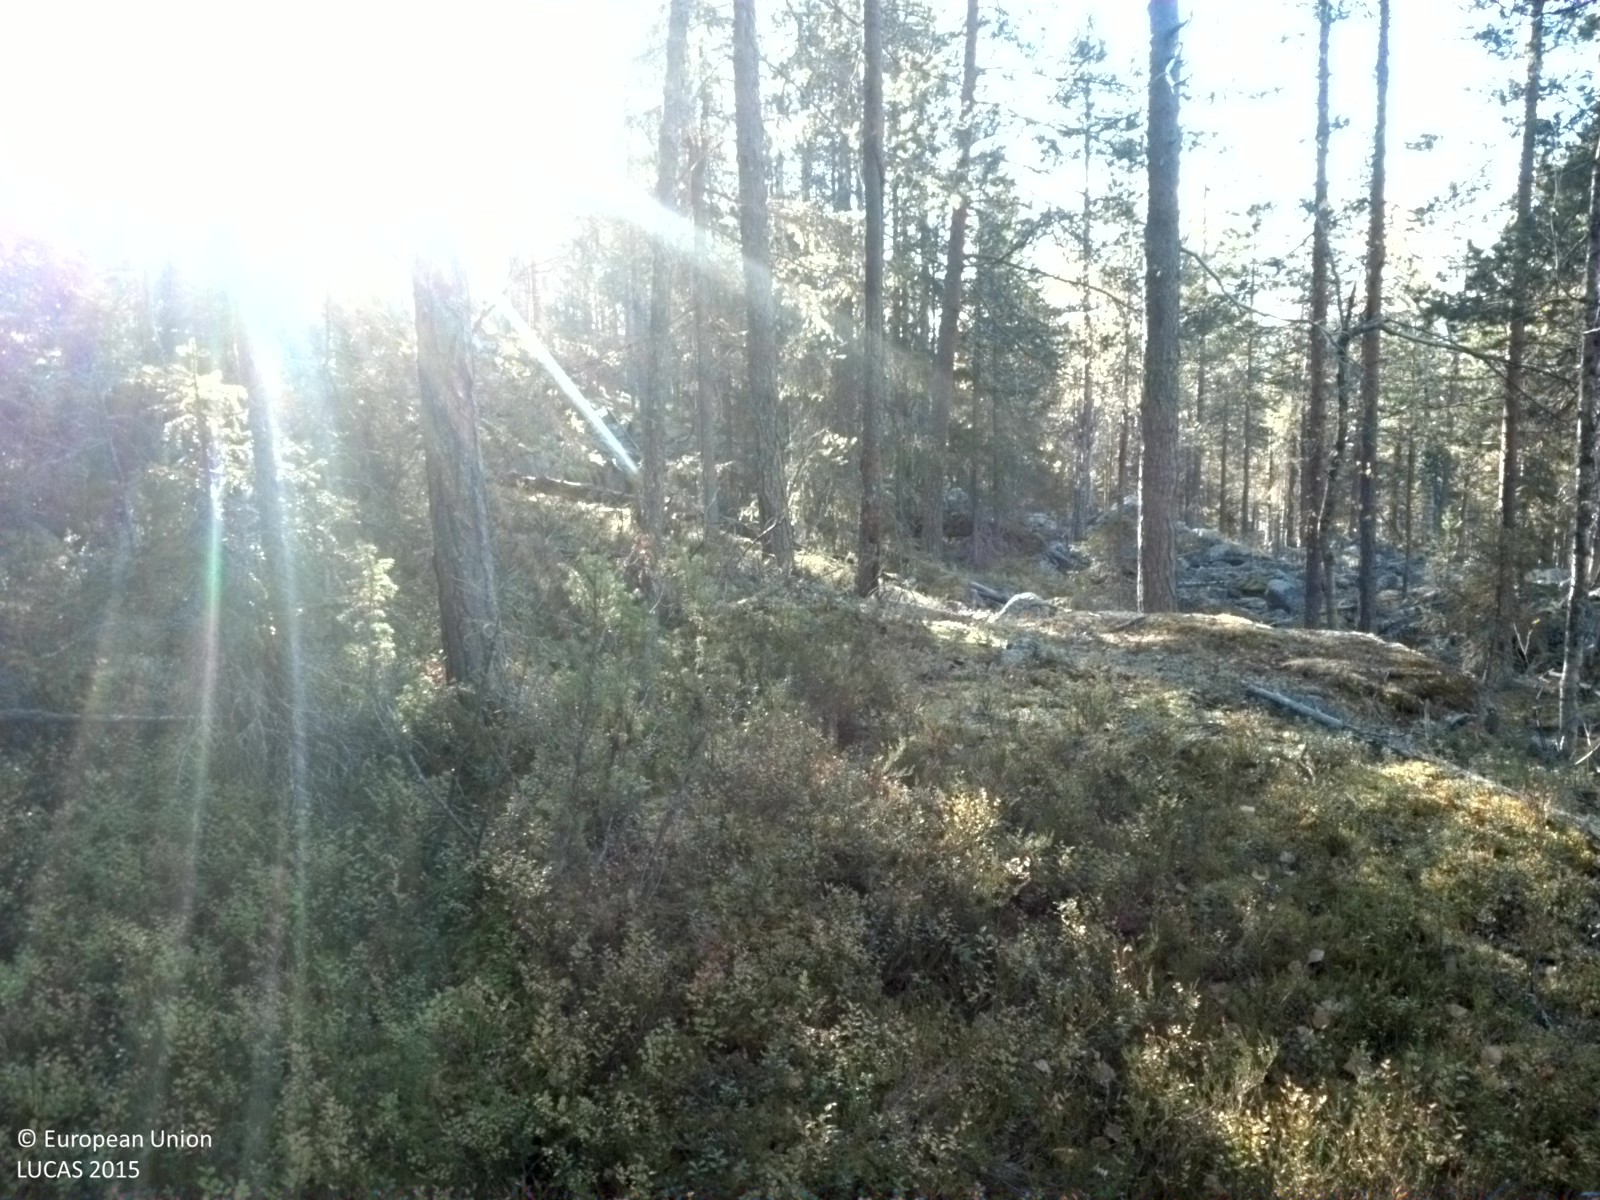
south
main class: Woodland
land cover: Pine dominated coniferous woodland
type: boreal forest
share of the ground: 25 - 50 %
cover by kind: shrubs 50 %, coniferous forest trees 30 %, consolidated bare surface 15 %, lichens and mosses 5 %
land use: Forestry
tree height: > 5 m
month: October
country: SE
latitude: 66.0694
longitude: 21.9685
